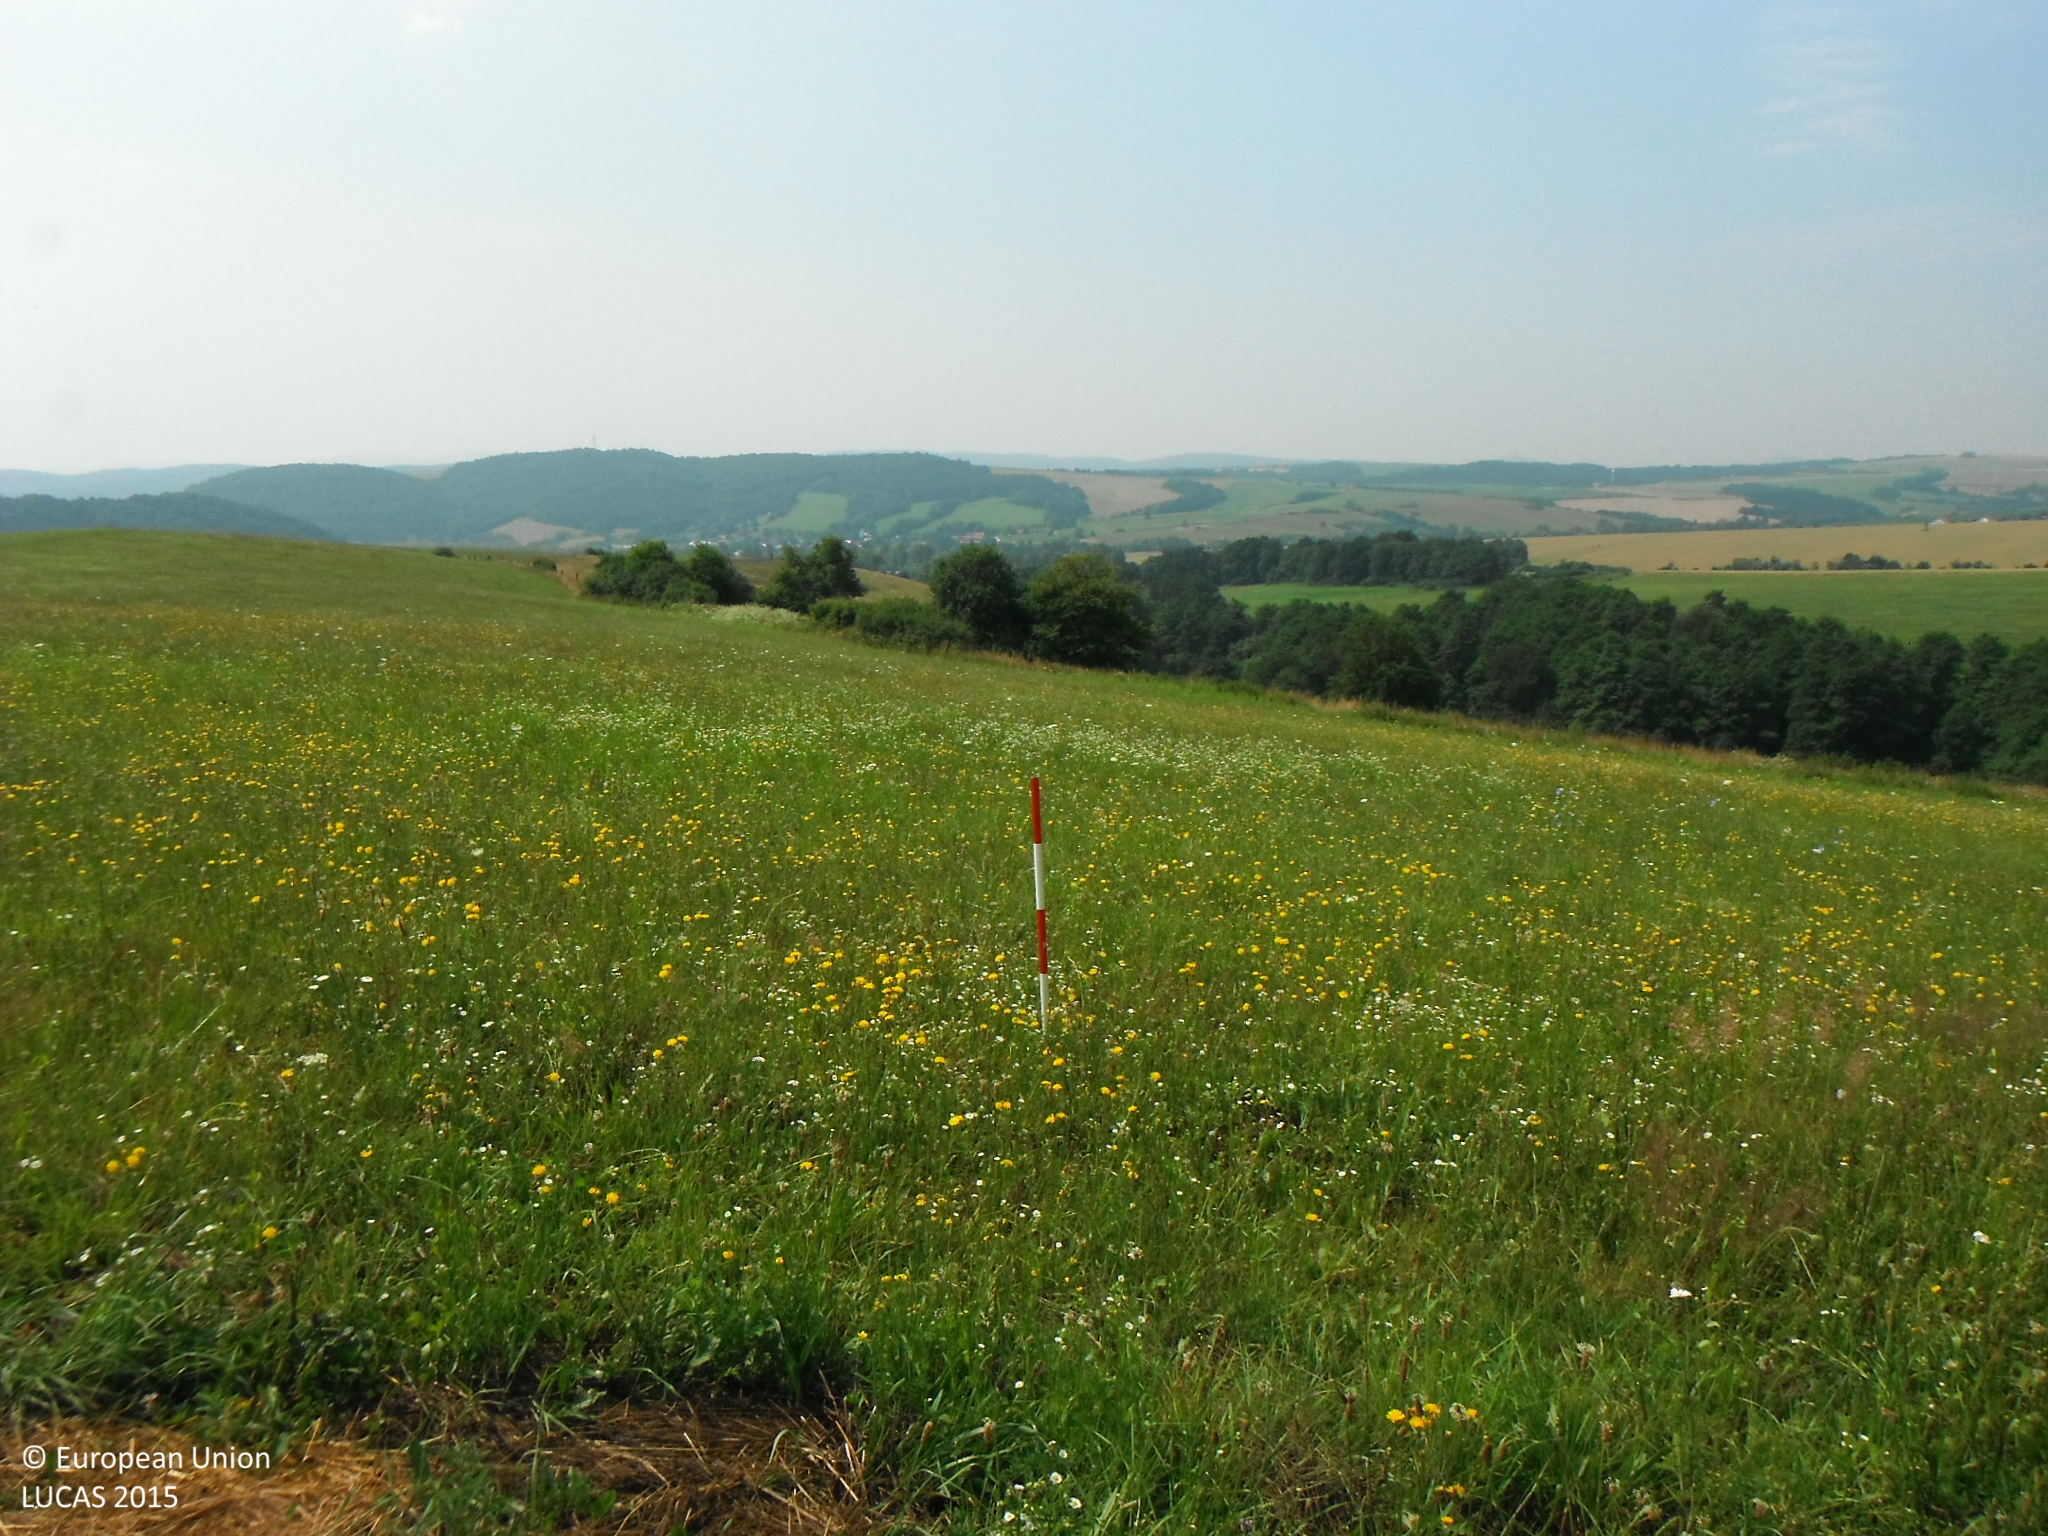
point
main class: Grassland
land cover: Grassland without tree/shrub cover
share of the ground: > 75 %
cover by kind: herbaceous plants 90 %, unconsolidated bare surface 10 %
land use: Agriculture (excluding fallow land and kitchen gardens)
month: July
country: SK
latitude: 49.2079
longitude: 21.4269
